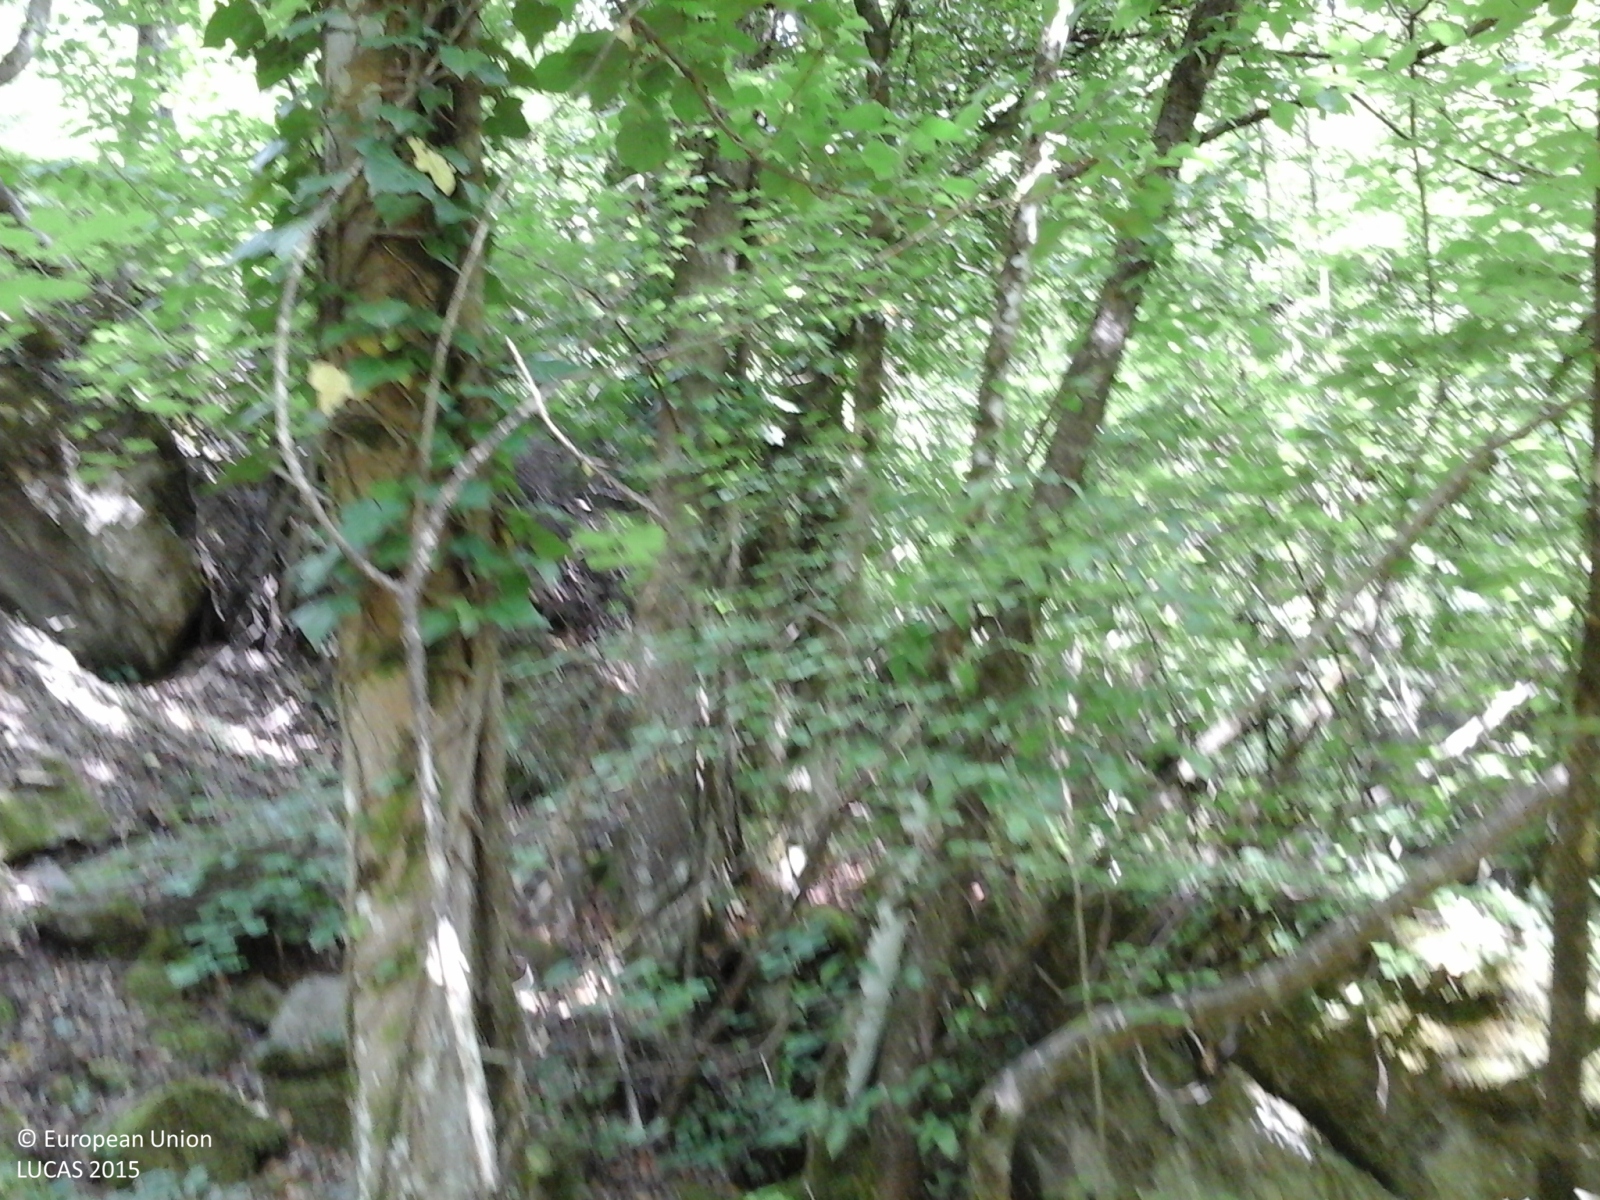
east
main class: Woodland
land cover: Broadleaved woodland
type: thermophilous deciduous forest
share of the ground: > 75 %
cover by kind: broadleaved forest trees 95 %, shrubs 5 %
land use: Semi-natural and natural areas not in use
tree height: > 5 m
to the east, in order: Broadleaved woodland; Fences; Grassland without tree/shrub cover; Tracks; Ditches and canals; Grassland without tree/shrub cover; Paved roads, cycling and walking lanes; Broadleaved woodland
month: June
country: IT
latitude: 43.8821
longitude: 11.8996
